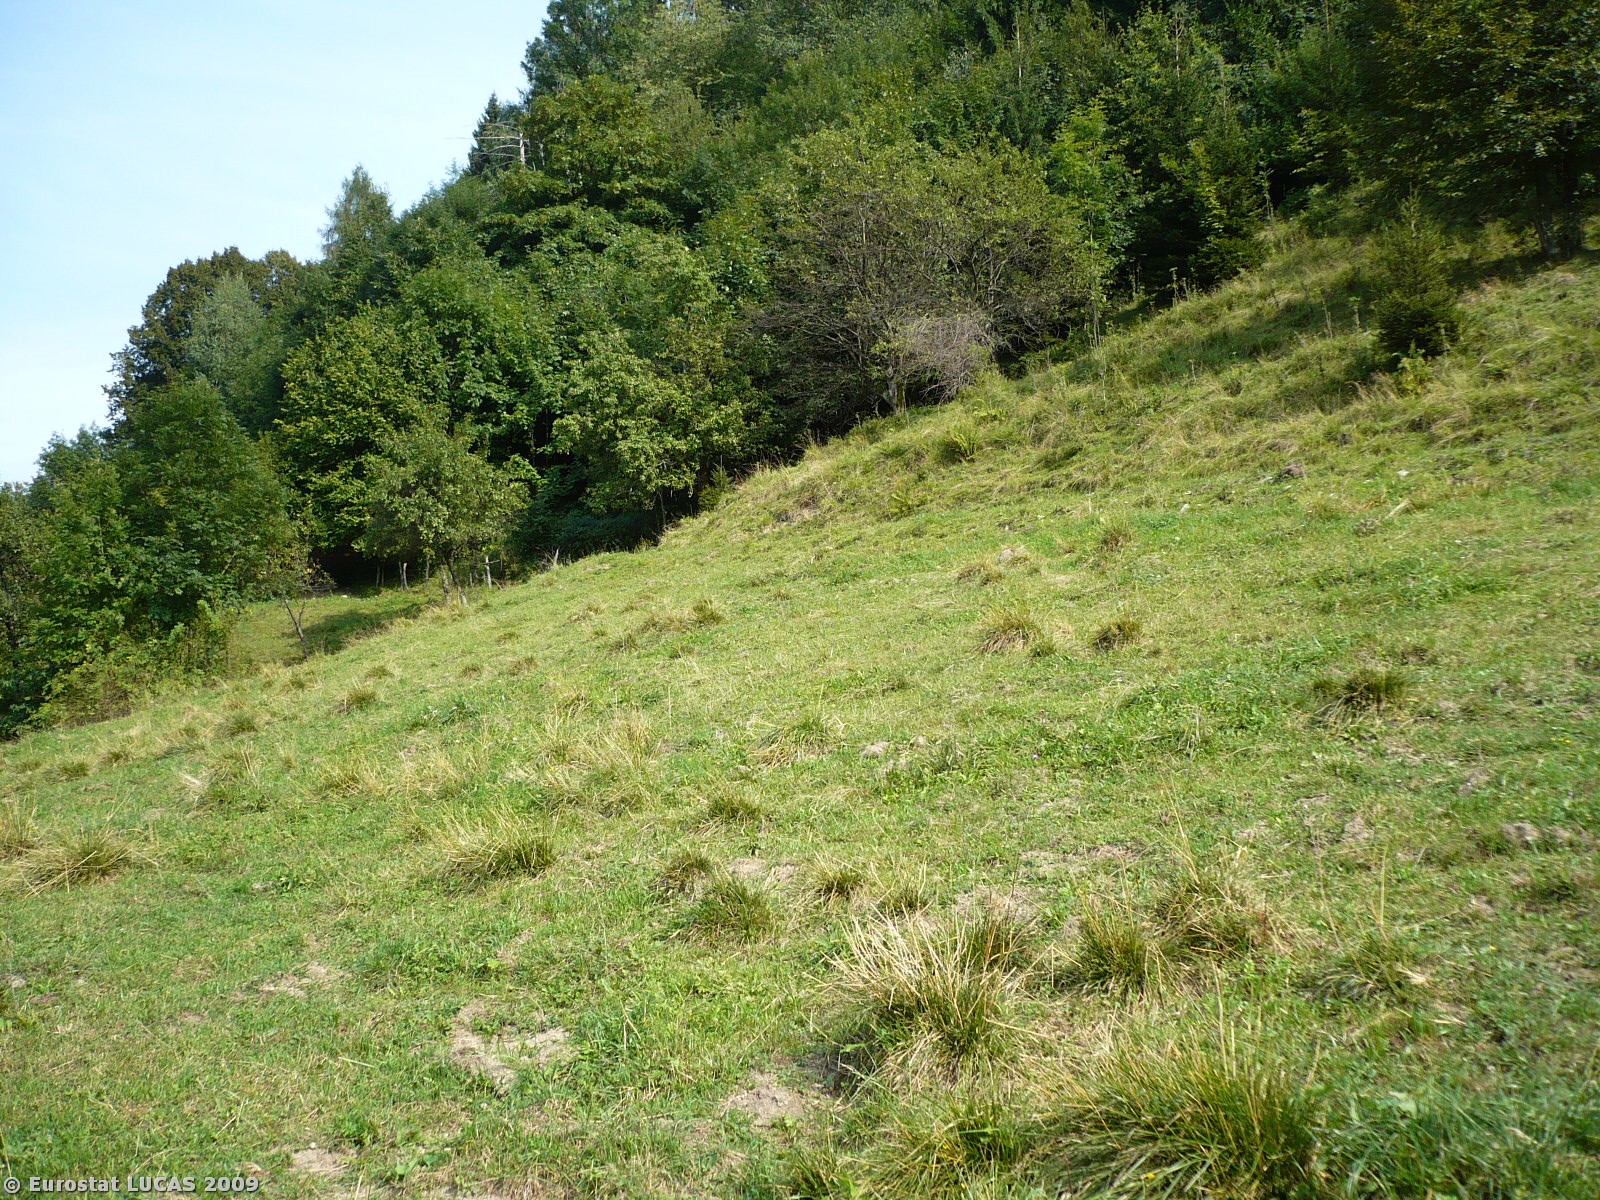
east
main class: Grassland
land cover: Grassland without tree/shrub cover
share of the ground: > 75 %
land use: Agriculture (excluding fallow land and kitchen gardens)
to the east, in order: Grassland without tree/shrub cover; Tracks; Broadleaved woodland; Fences; Broadleaved woodland; Ditches and canals; Broadleaved woodland
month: August
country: SI
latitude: 46.1983
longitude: 13.6639
